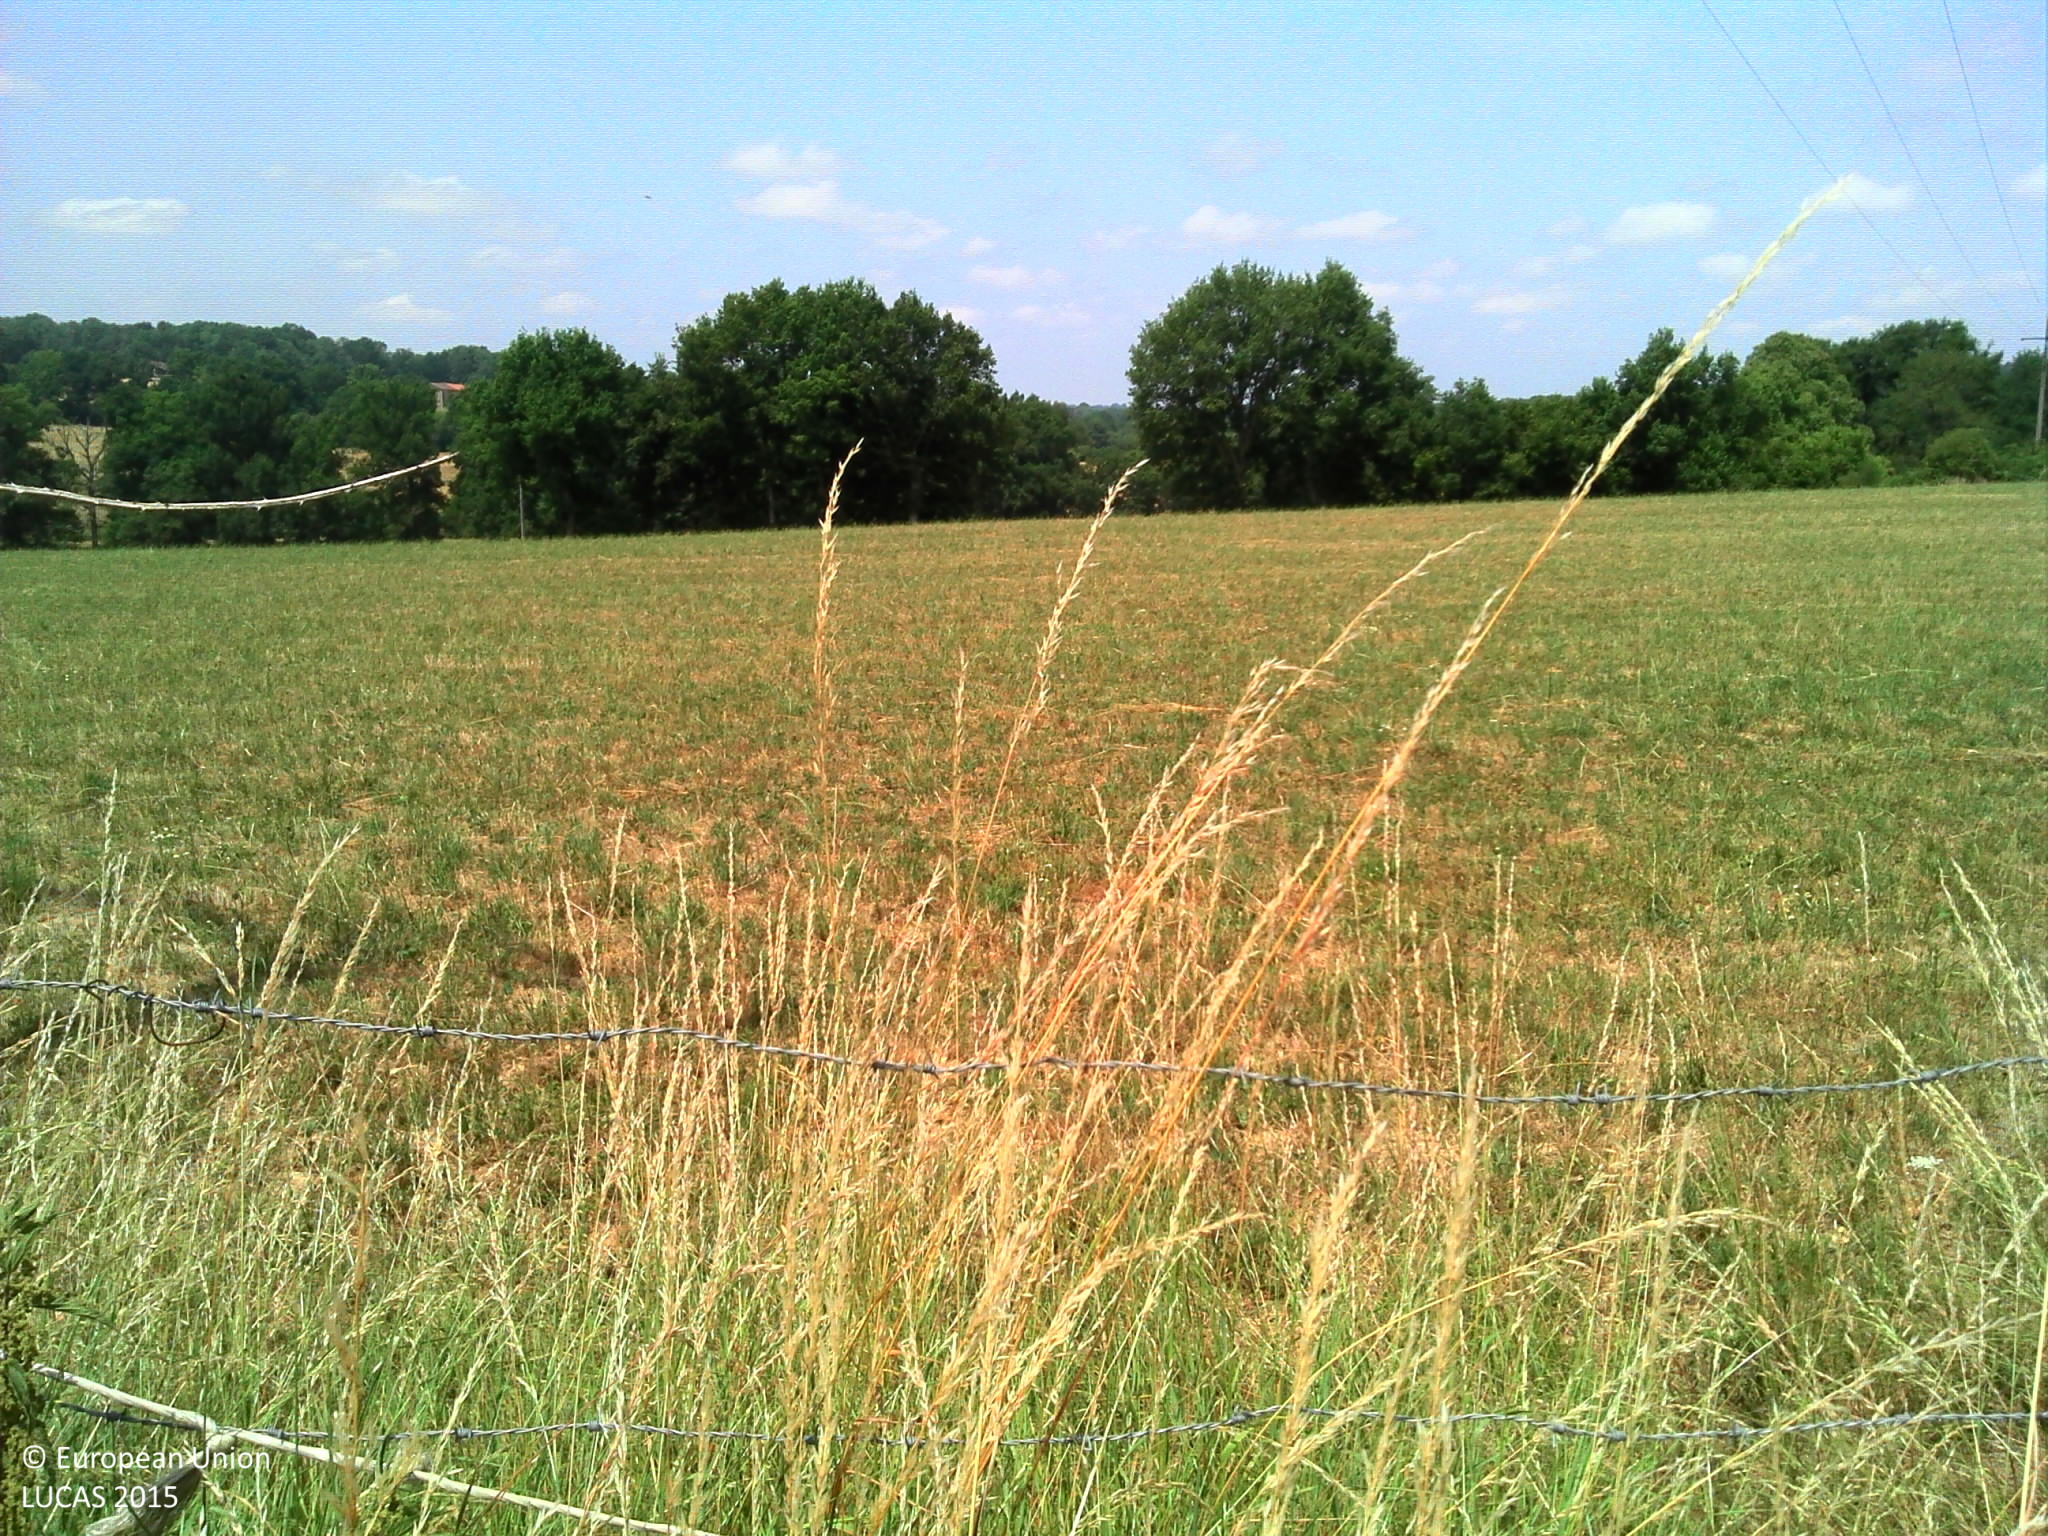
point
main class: Grassland
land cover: Grassland without tree/shrub cover
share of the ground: > 75 %
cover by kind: herbaceous plants 95 %
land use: Agriculture (excluding fallow land and kitchen gardens)
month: July
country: FR
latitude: 45.7340
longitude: 0.9809
